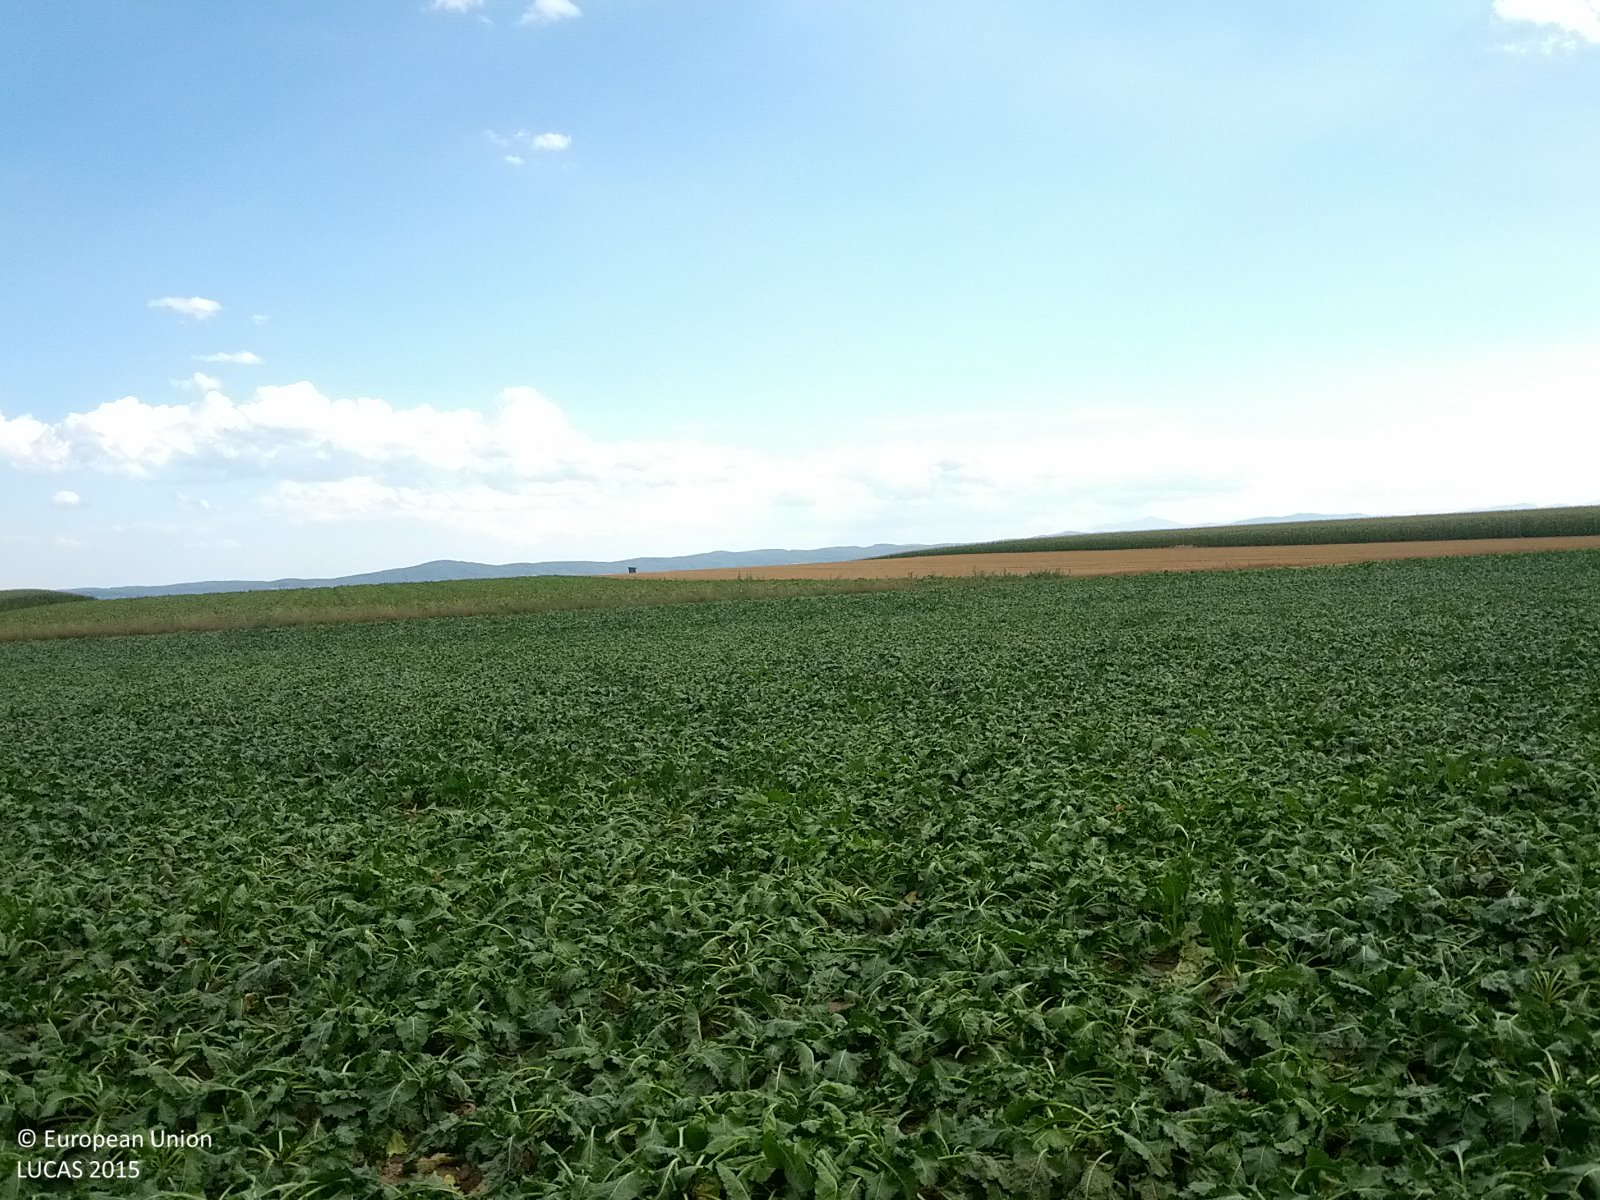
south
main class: Cropland
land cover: Sugar beet
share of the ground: > 75 %
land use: Agriculture (excluding fallow land and kitchen gardens)
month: July
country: AT
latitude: 48.4141
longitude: 16.1249
